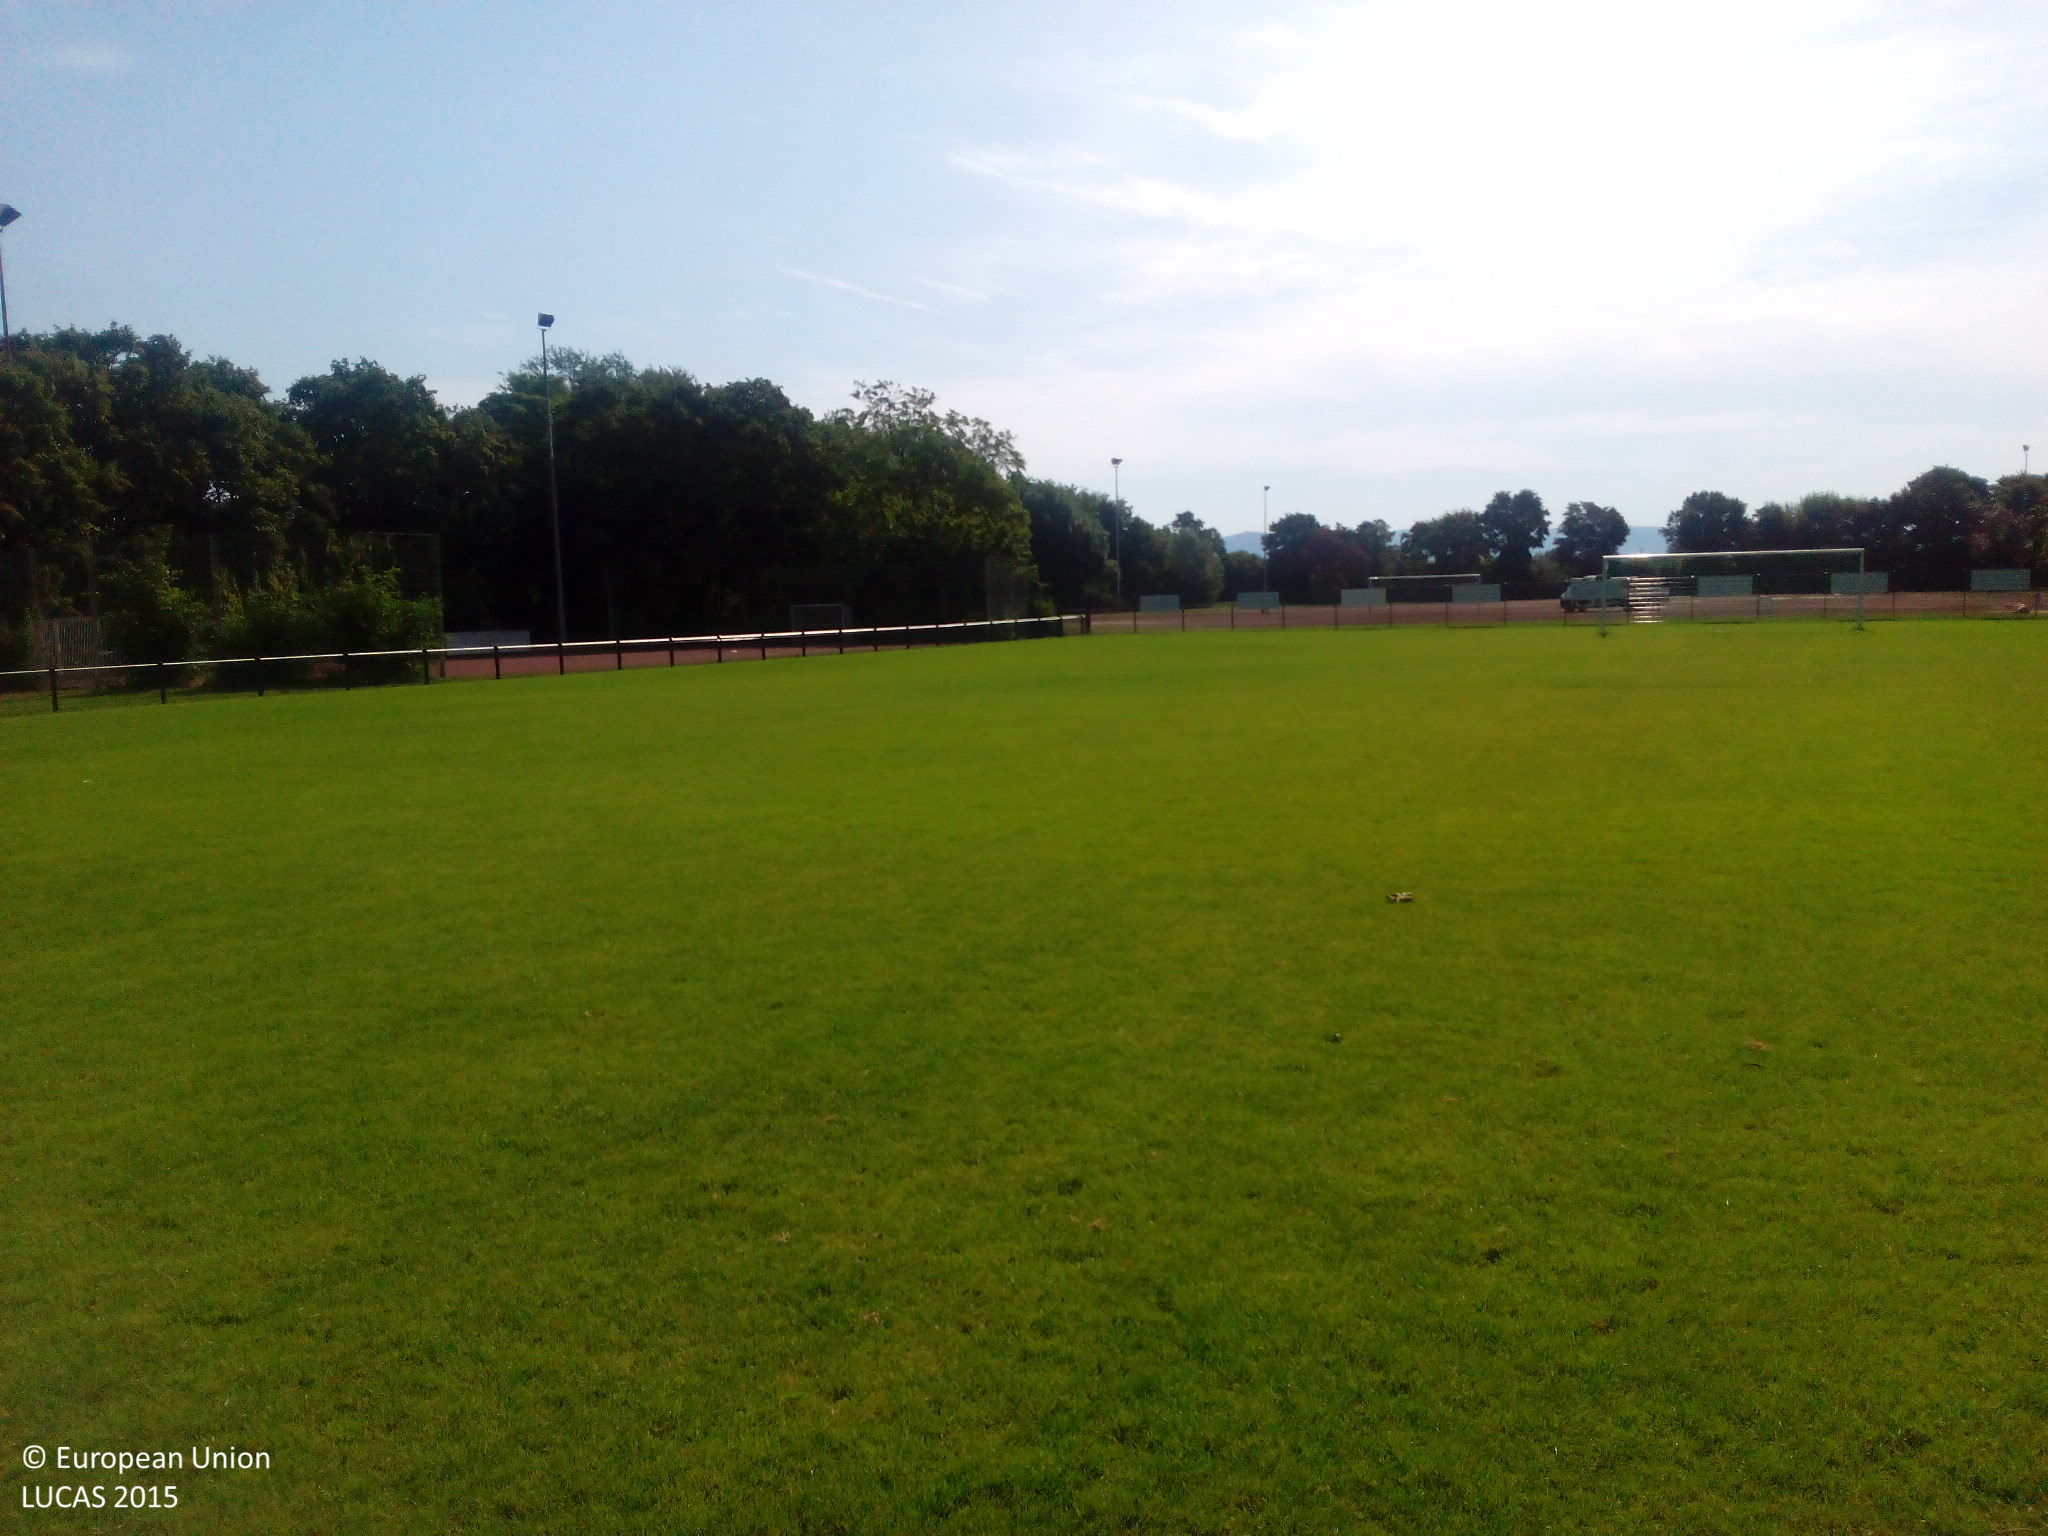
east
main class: Grassland
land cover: Grassland without tree/shrub cover
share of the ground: > 75 %
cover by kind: herbaceous plants 95 %, unconsolidated bare surface 5 %
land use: Sport
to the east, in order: Grassland without tree/shrub cover; Artificial constructions in urban areas
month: August
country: DE
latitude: 49.4736
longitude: 8.5514
